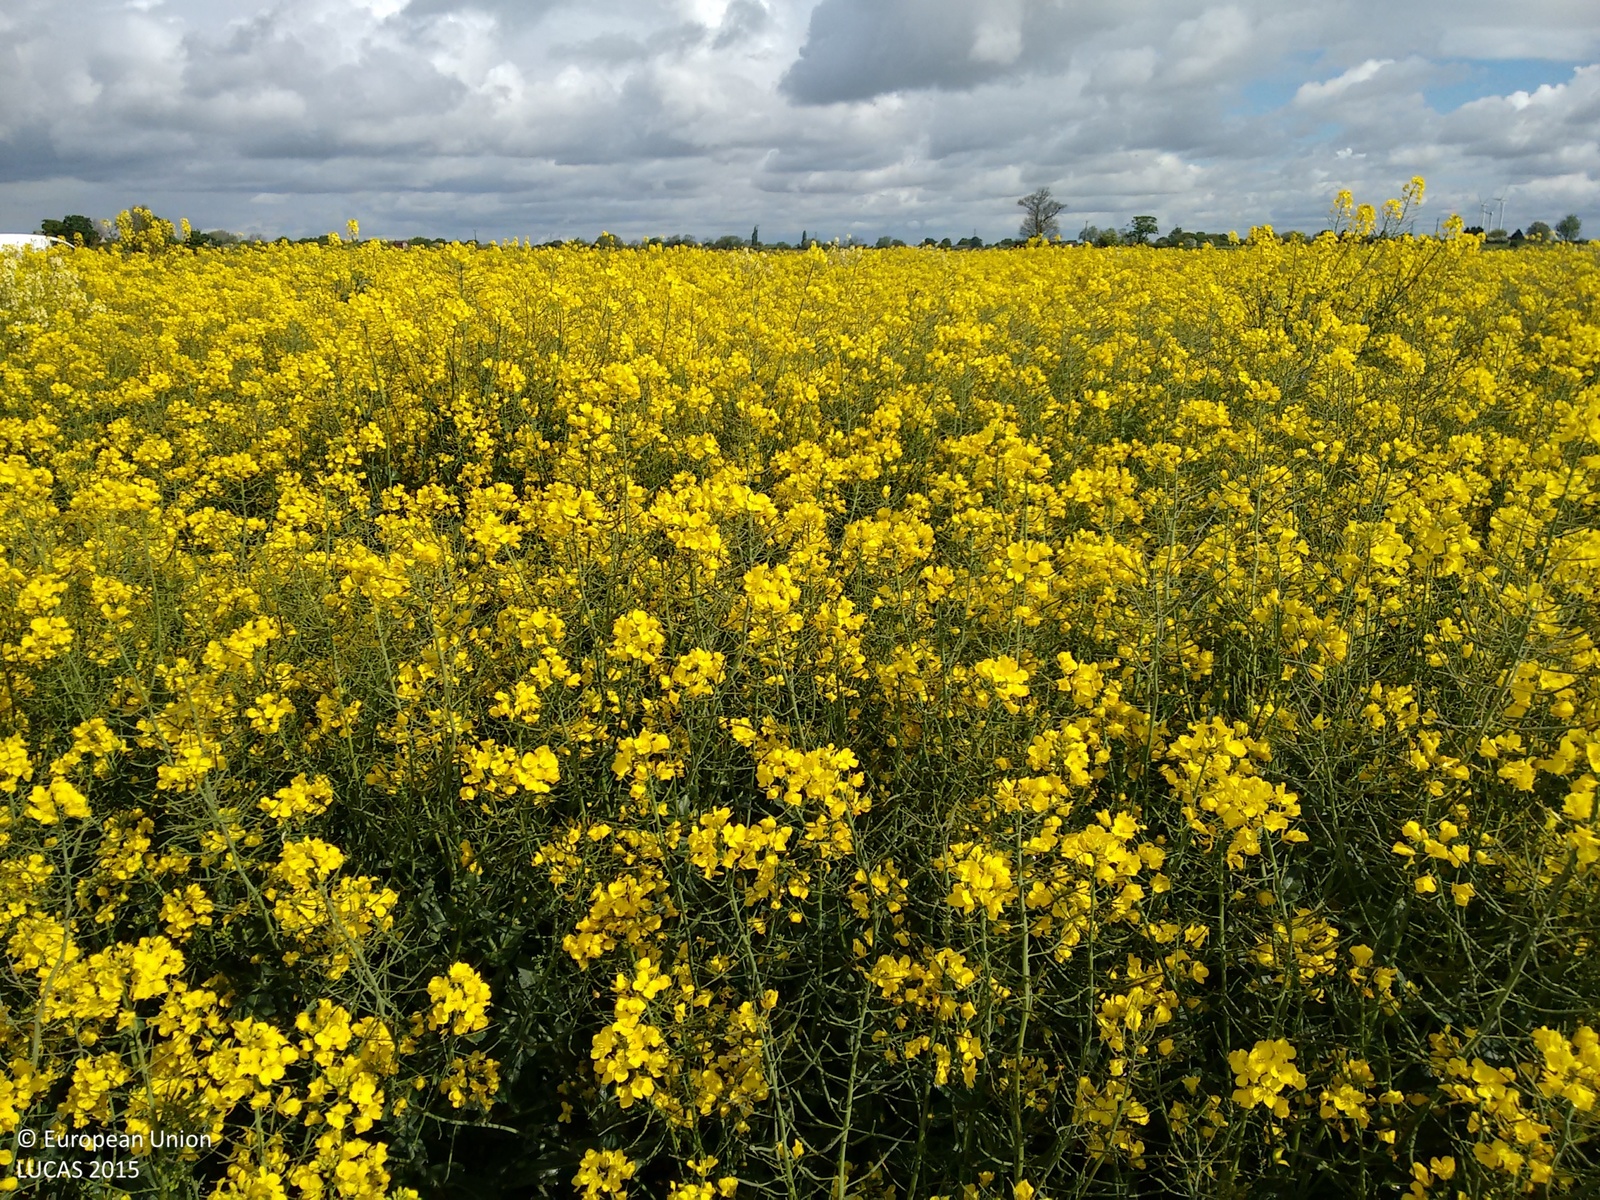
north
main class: Cropland
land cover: Rape and turnip rape
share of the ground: > 75 %
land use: Agriculture (excluding fallow land and kitchen gardens)
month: May
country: GB
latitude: 53.5947
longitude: -0.9361
